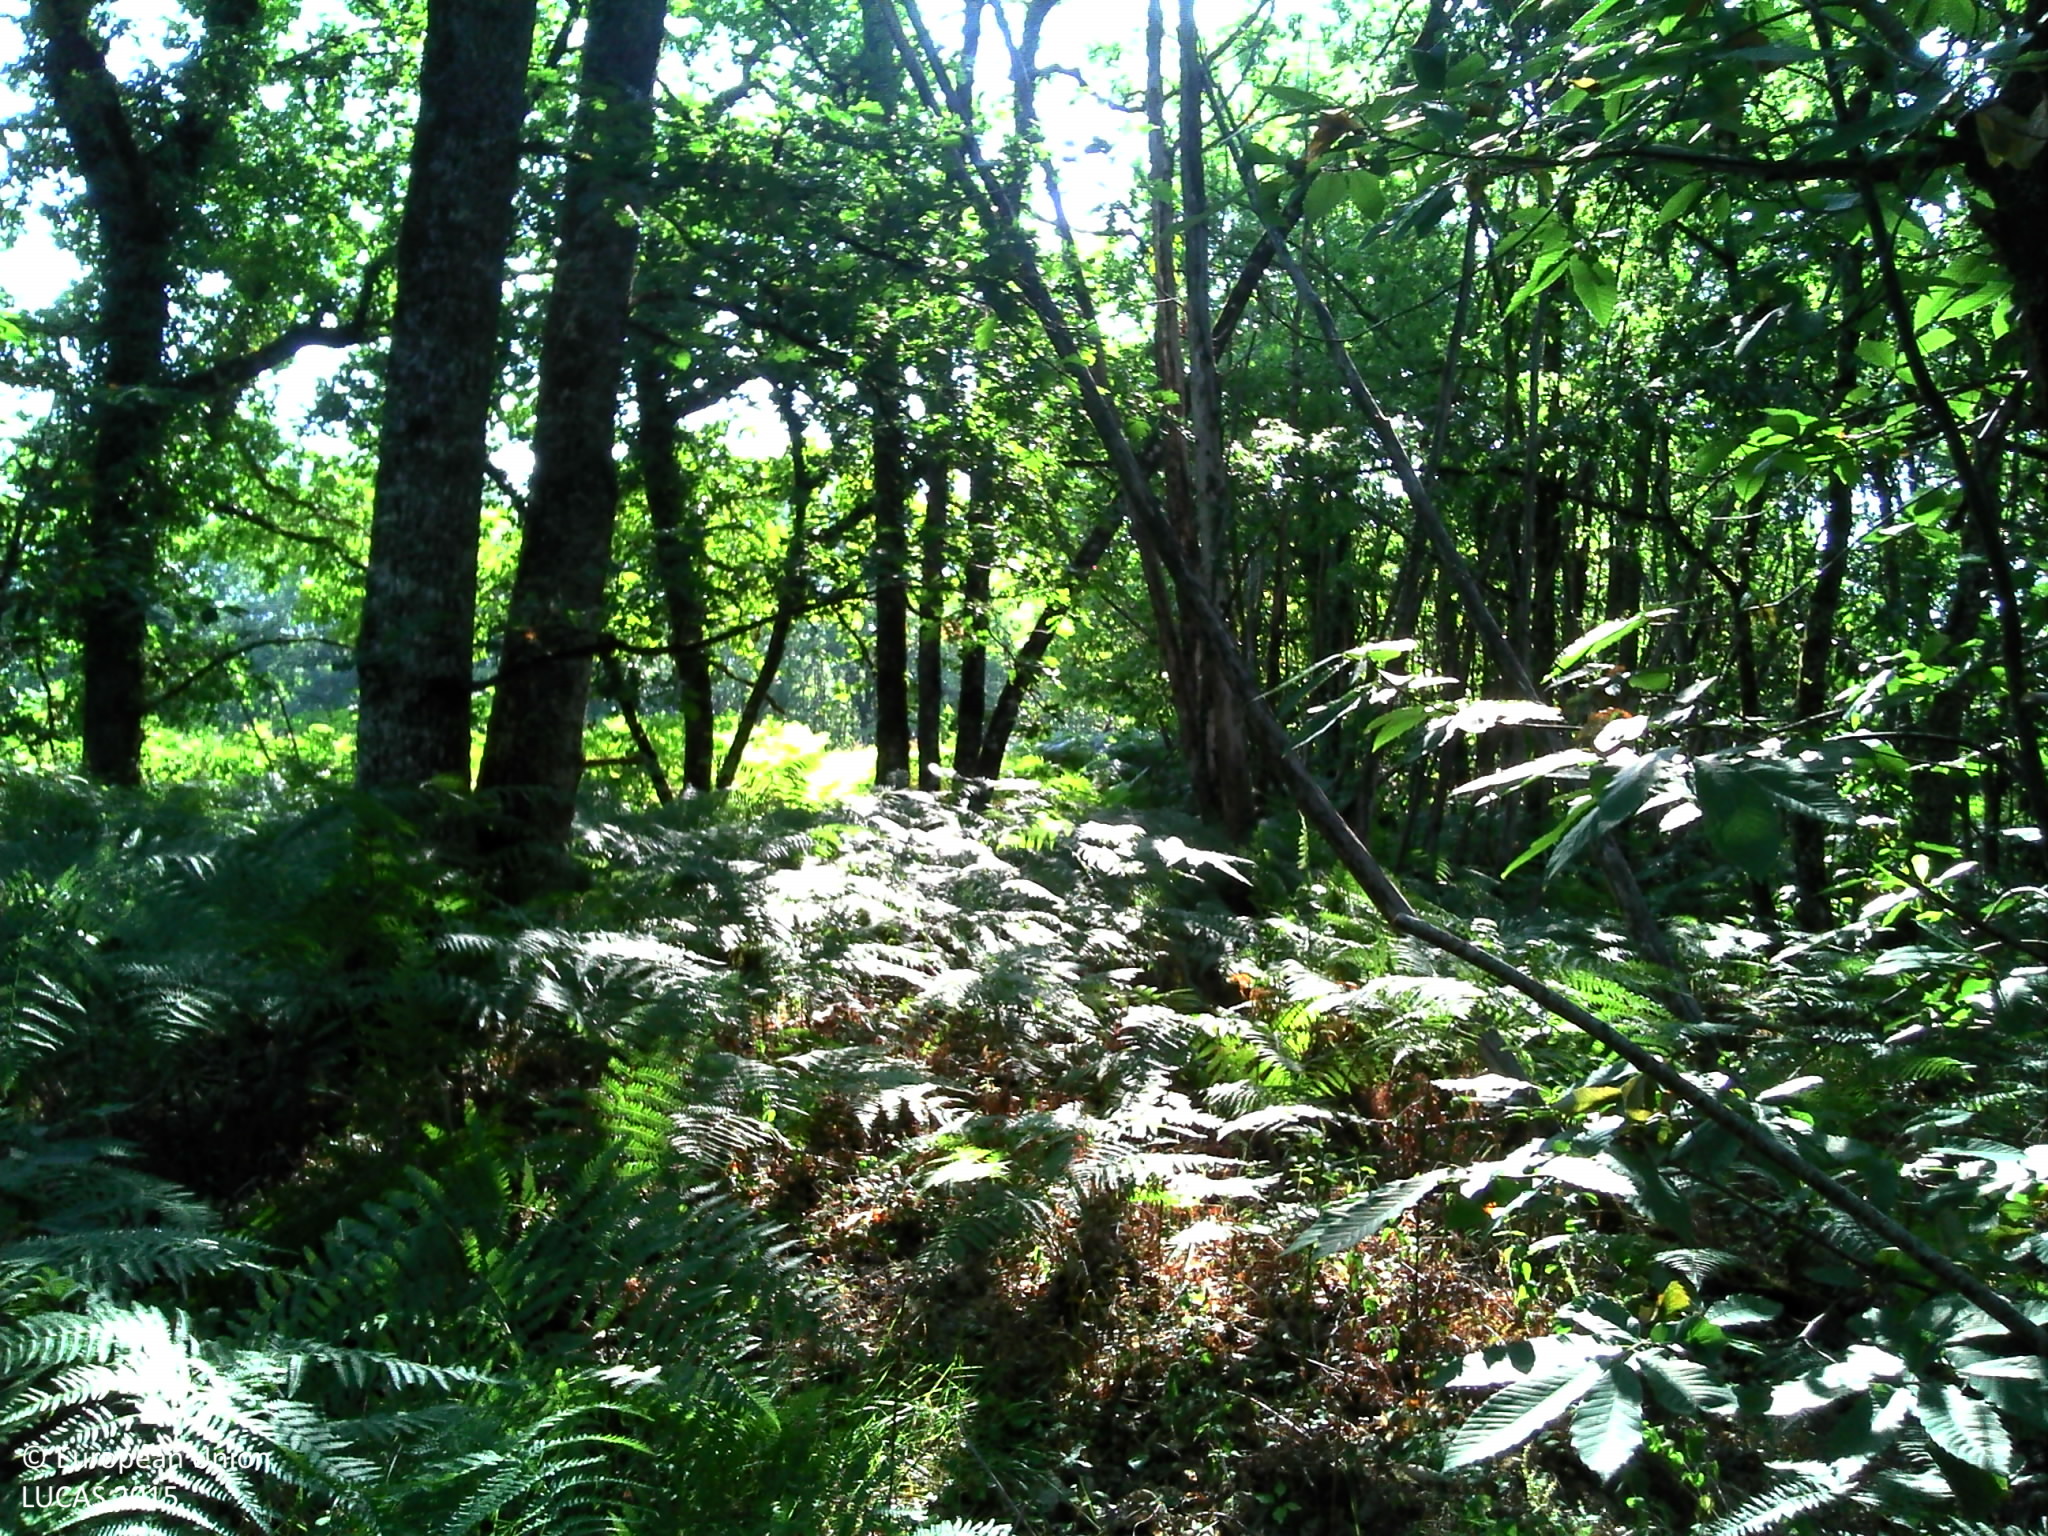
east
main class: Woodland
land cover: Broadleaved woodland
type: thermophilous deciduous forest
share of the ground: > 75 %
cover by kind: broadleaved forest trees 80 %, herbaceous plants 10 %, shrubs 5 %, lichens and mosses 5 %
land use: Forestry
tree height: > 5 m
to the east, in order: Broadleaved woodland; Fences; Grassland without tree/shrub cover; Fences; Broadleaved woodland
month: August
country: FR
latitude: 44.7962
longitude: 0.8280
